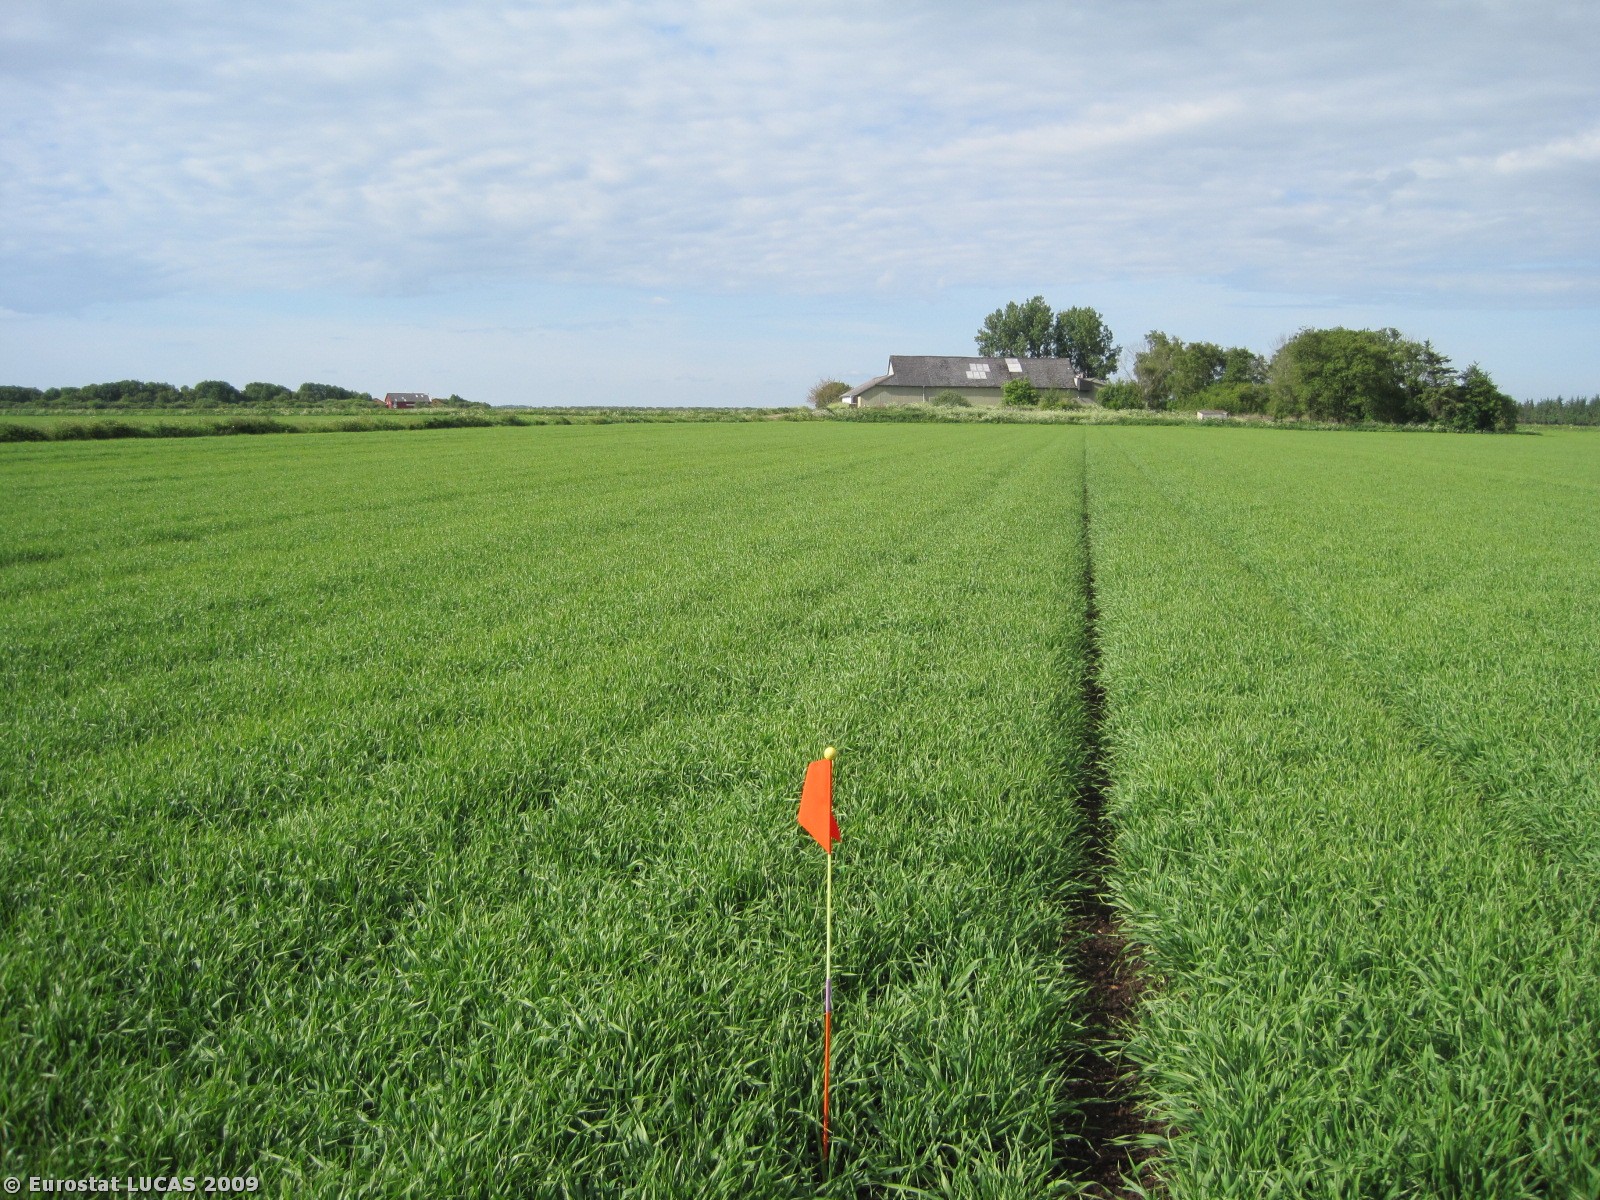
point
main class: Cropland
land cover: Barley
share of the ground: > 75 %
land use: Agriculture (excluding fallow land and kitchen gardens)
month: June
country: DK
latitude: 57.2123
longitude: 9.8182
